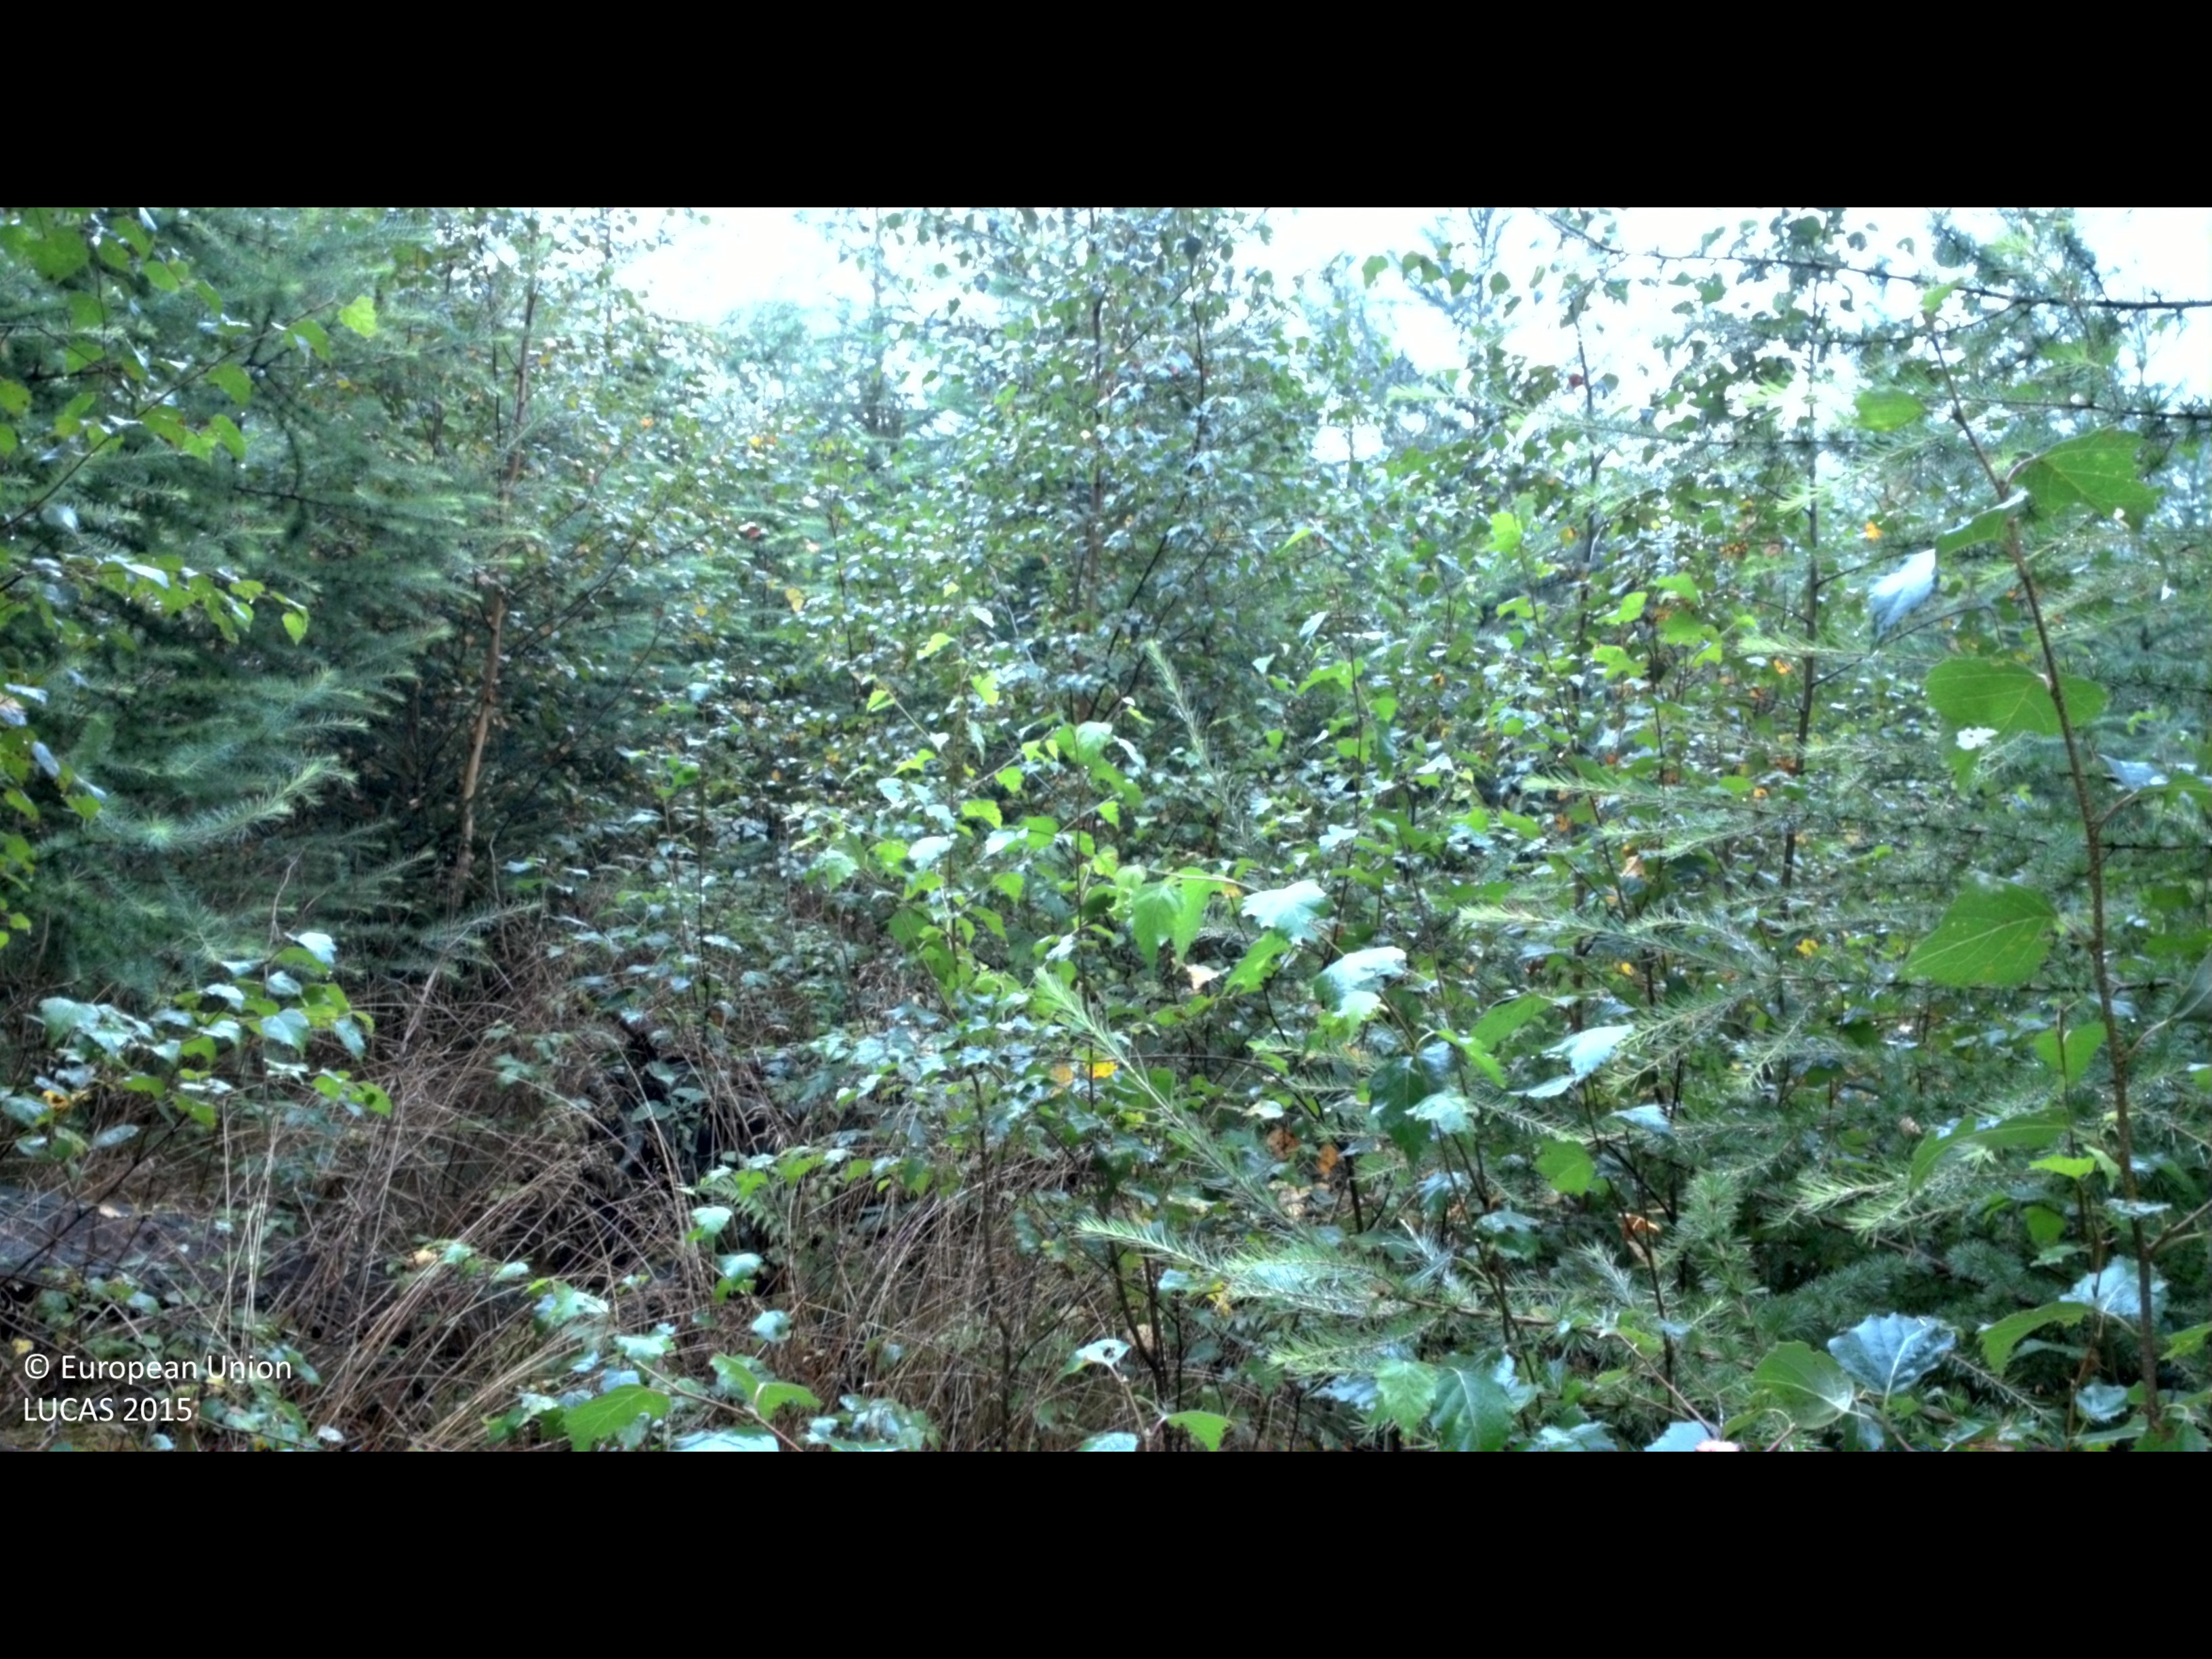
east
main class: Woodland
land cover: Other mixed woodland
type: boreal forest
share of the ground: 50 - 75 %
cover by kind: coniferous forest trees 35 %, broadleaved forest trees 35 %, shrubs 15 %, herbaceous plants 15 %
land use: Forestry
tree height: < 5 m
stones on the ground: 10 - 25 %
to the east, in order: Other mixed woodland; Ditches and canals; Paved roads, cycling and walking lanes; Spruce dominated coniferous woodland; Pine dominated coniferous woodland; Spruce dominated mixed woodland; Tracks; Spruce dominated coniferous woodland; Spruce dominated mixed woodland
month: August
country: SE
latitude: 57.3366
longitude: 13.8334
